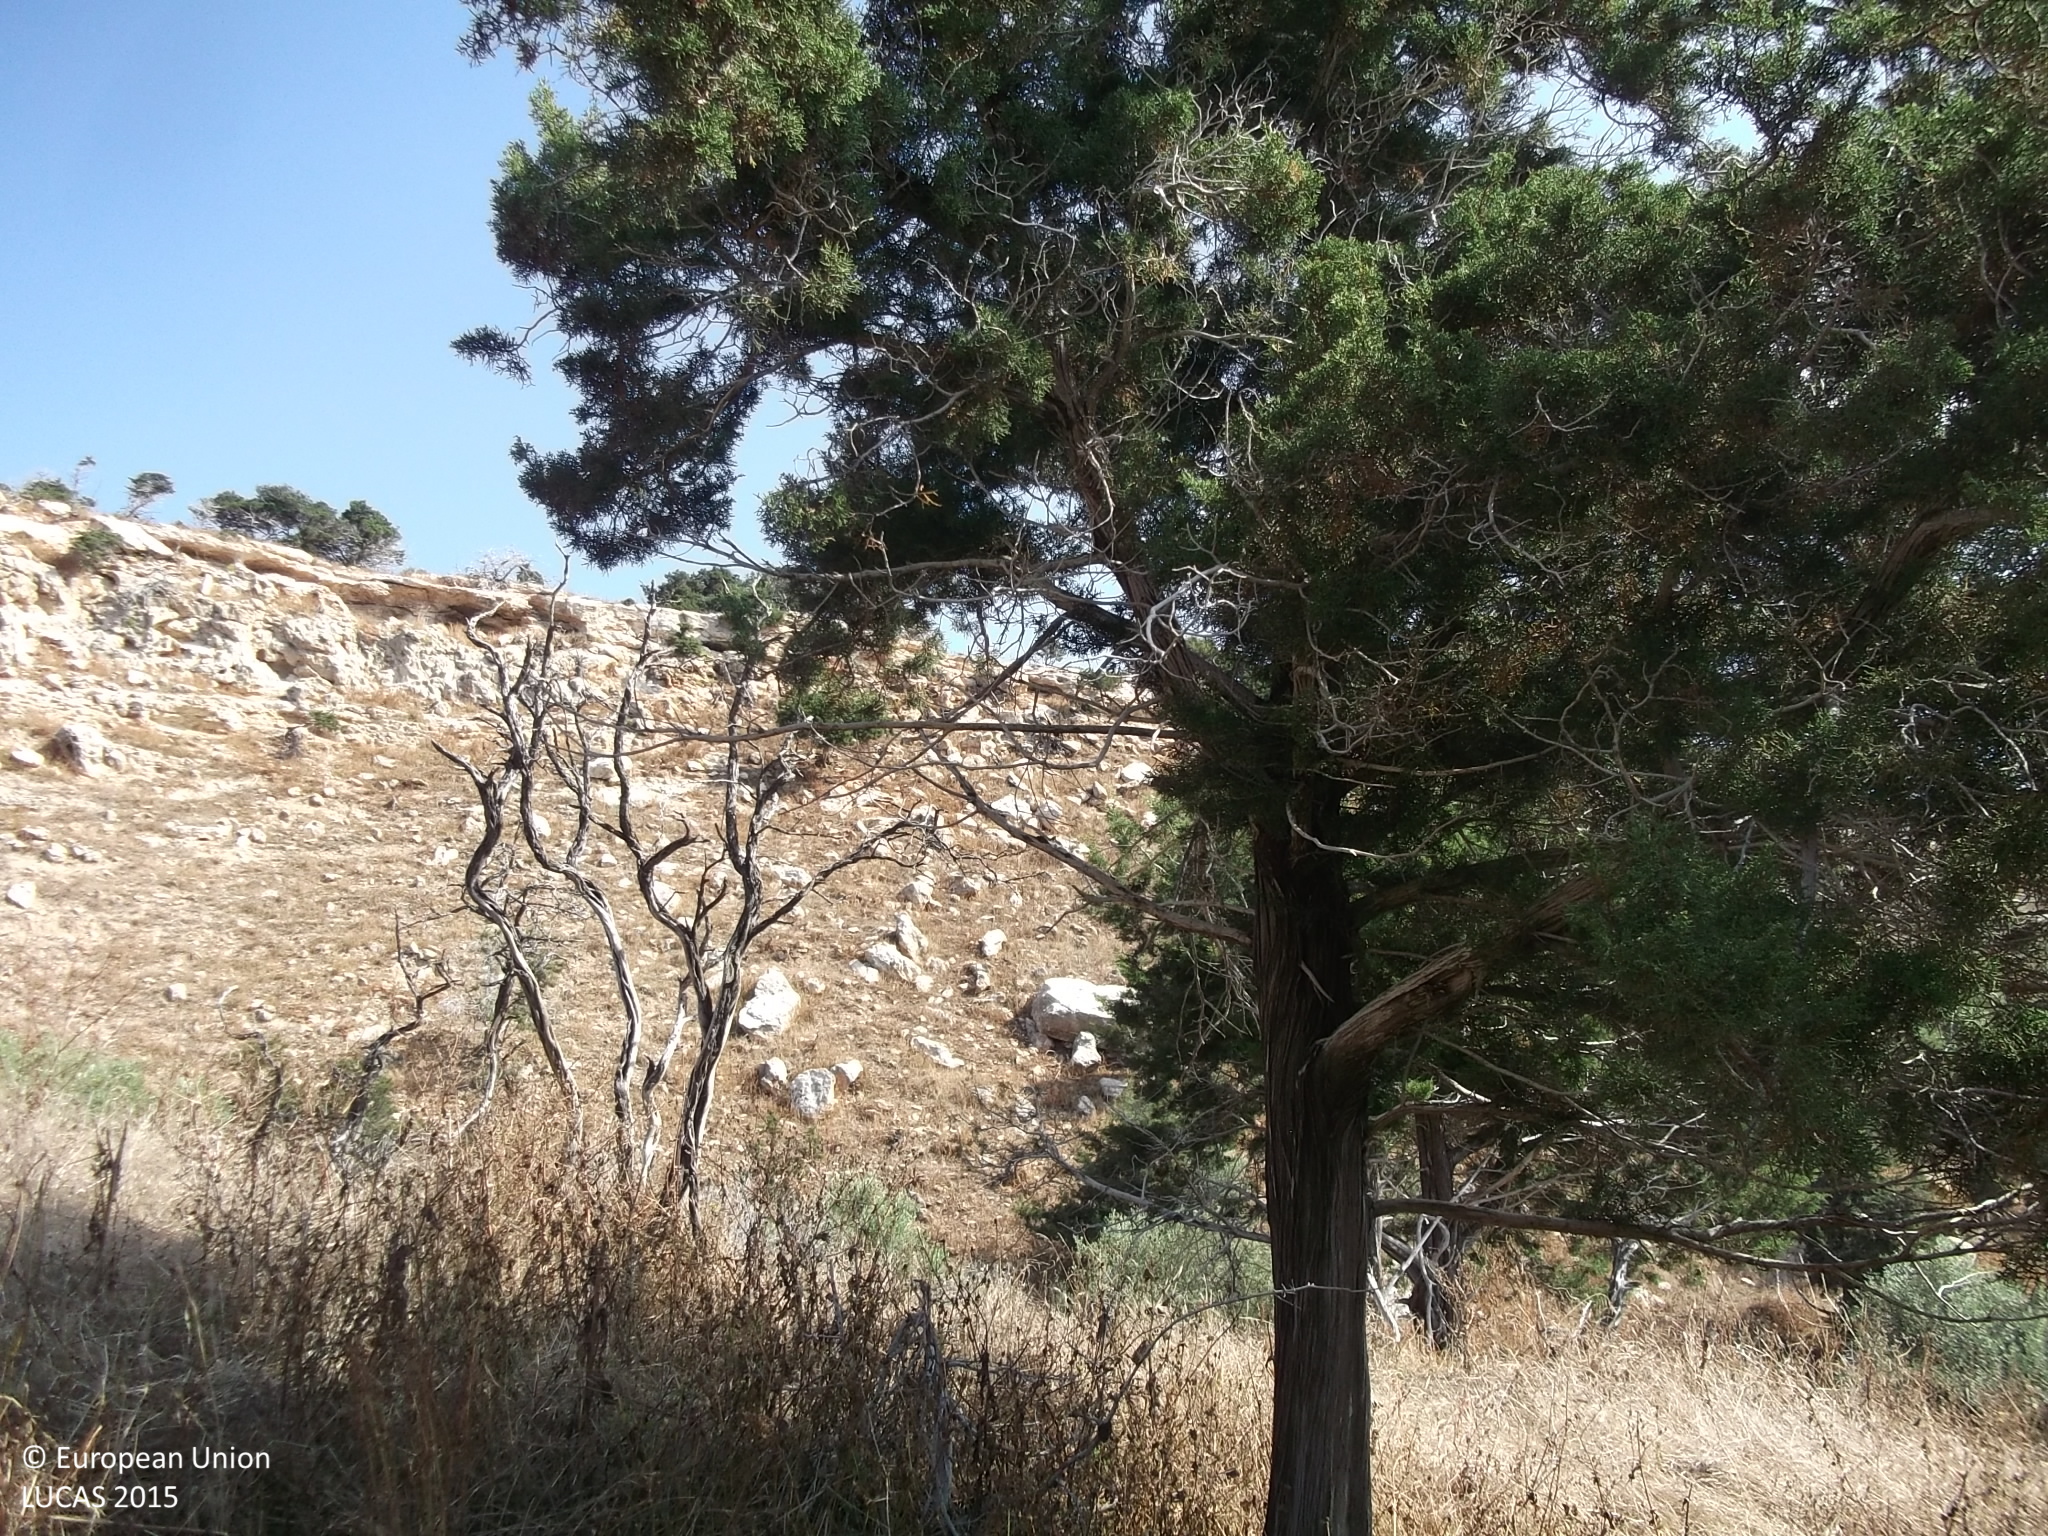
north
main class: Woodland
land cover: Other mixed woodland
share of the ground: 50 - 75 %
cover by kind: herbaceous plants 50 %, coniferous forest trees 30 %, broadleaved forest trees 20 %
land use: Agriculture (excluding fallow land and kitchen gardens)
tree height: < 5 m
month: May
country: CY
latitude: 35.0837
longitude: 32.2944
